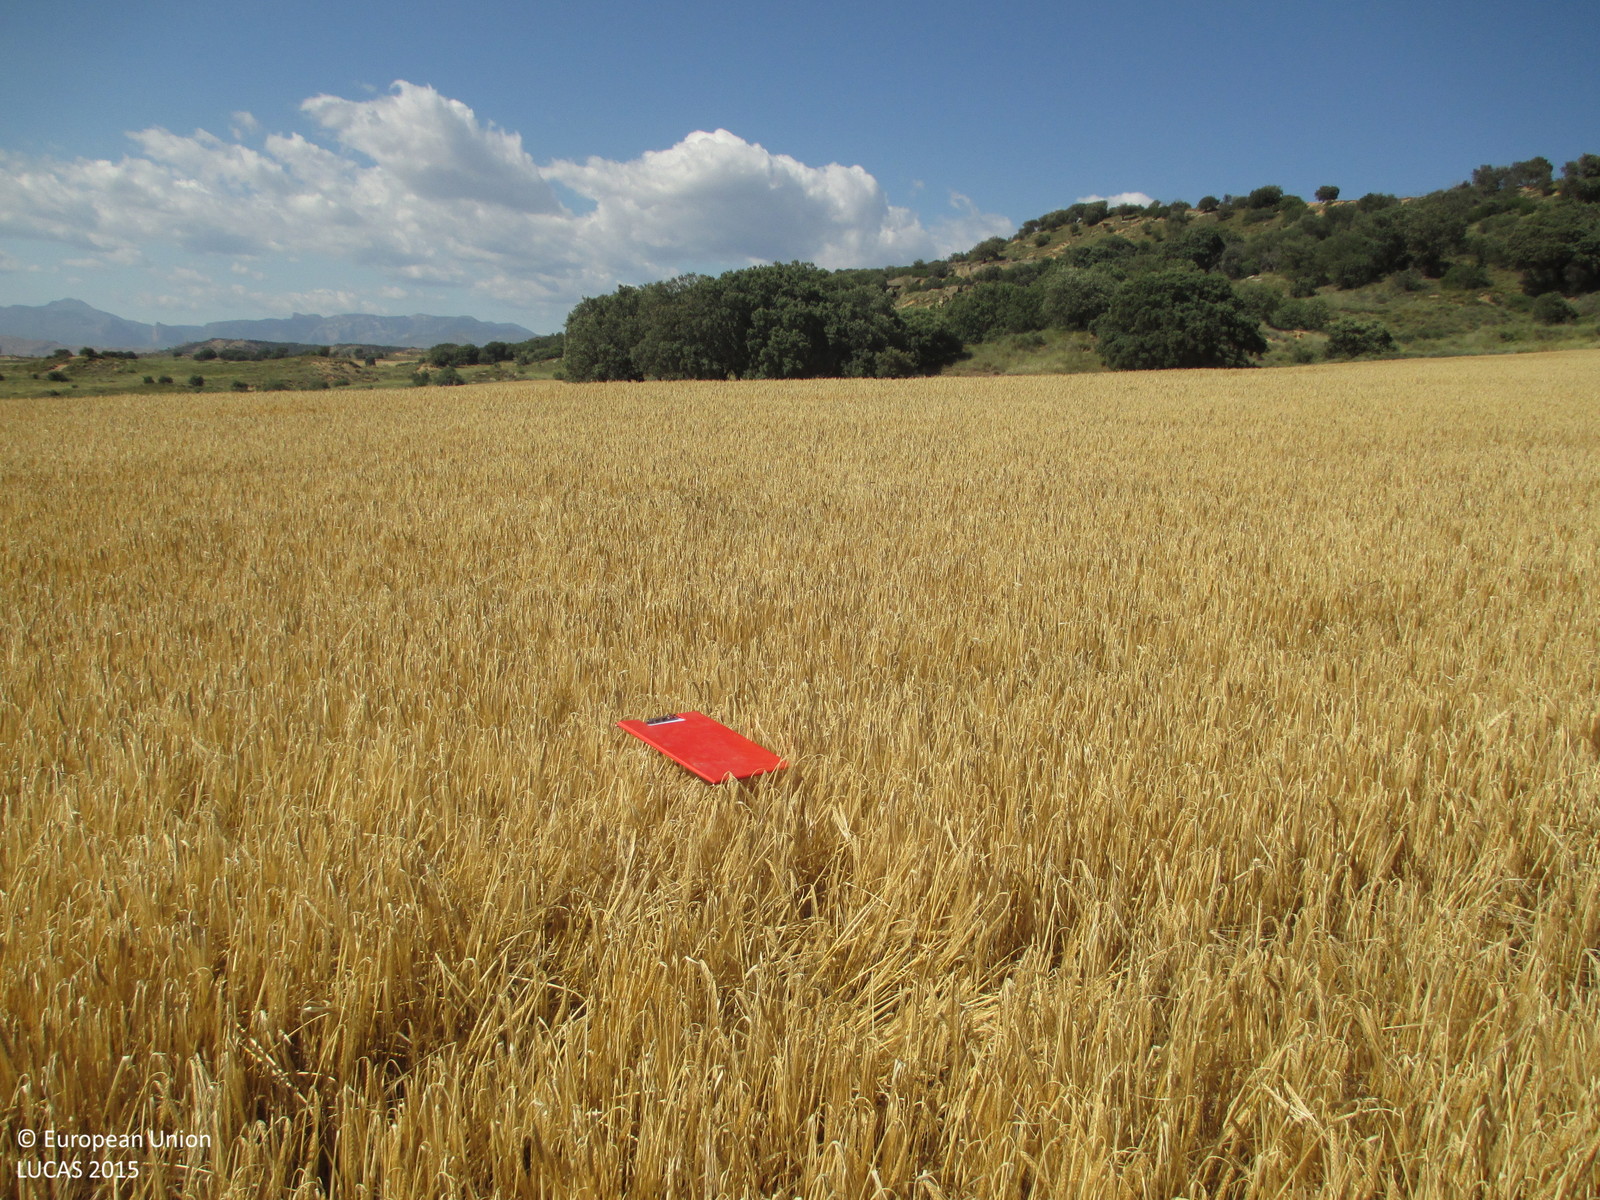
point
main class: Cropland
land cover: Barley
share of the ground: > 75 %
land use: Agriculture (excluding fallow land and kitchen gardens)
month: June
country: ES
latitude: 42.0698
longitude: -0.3308
